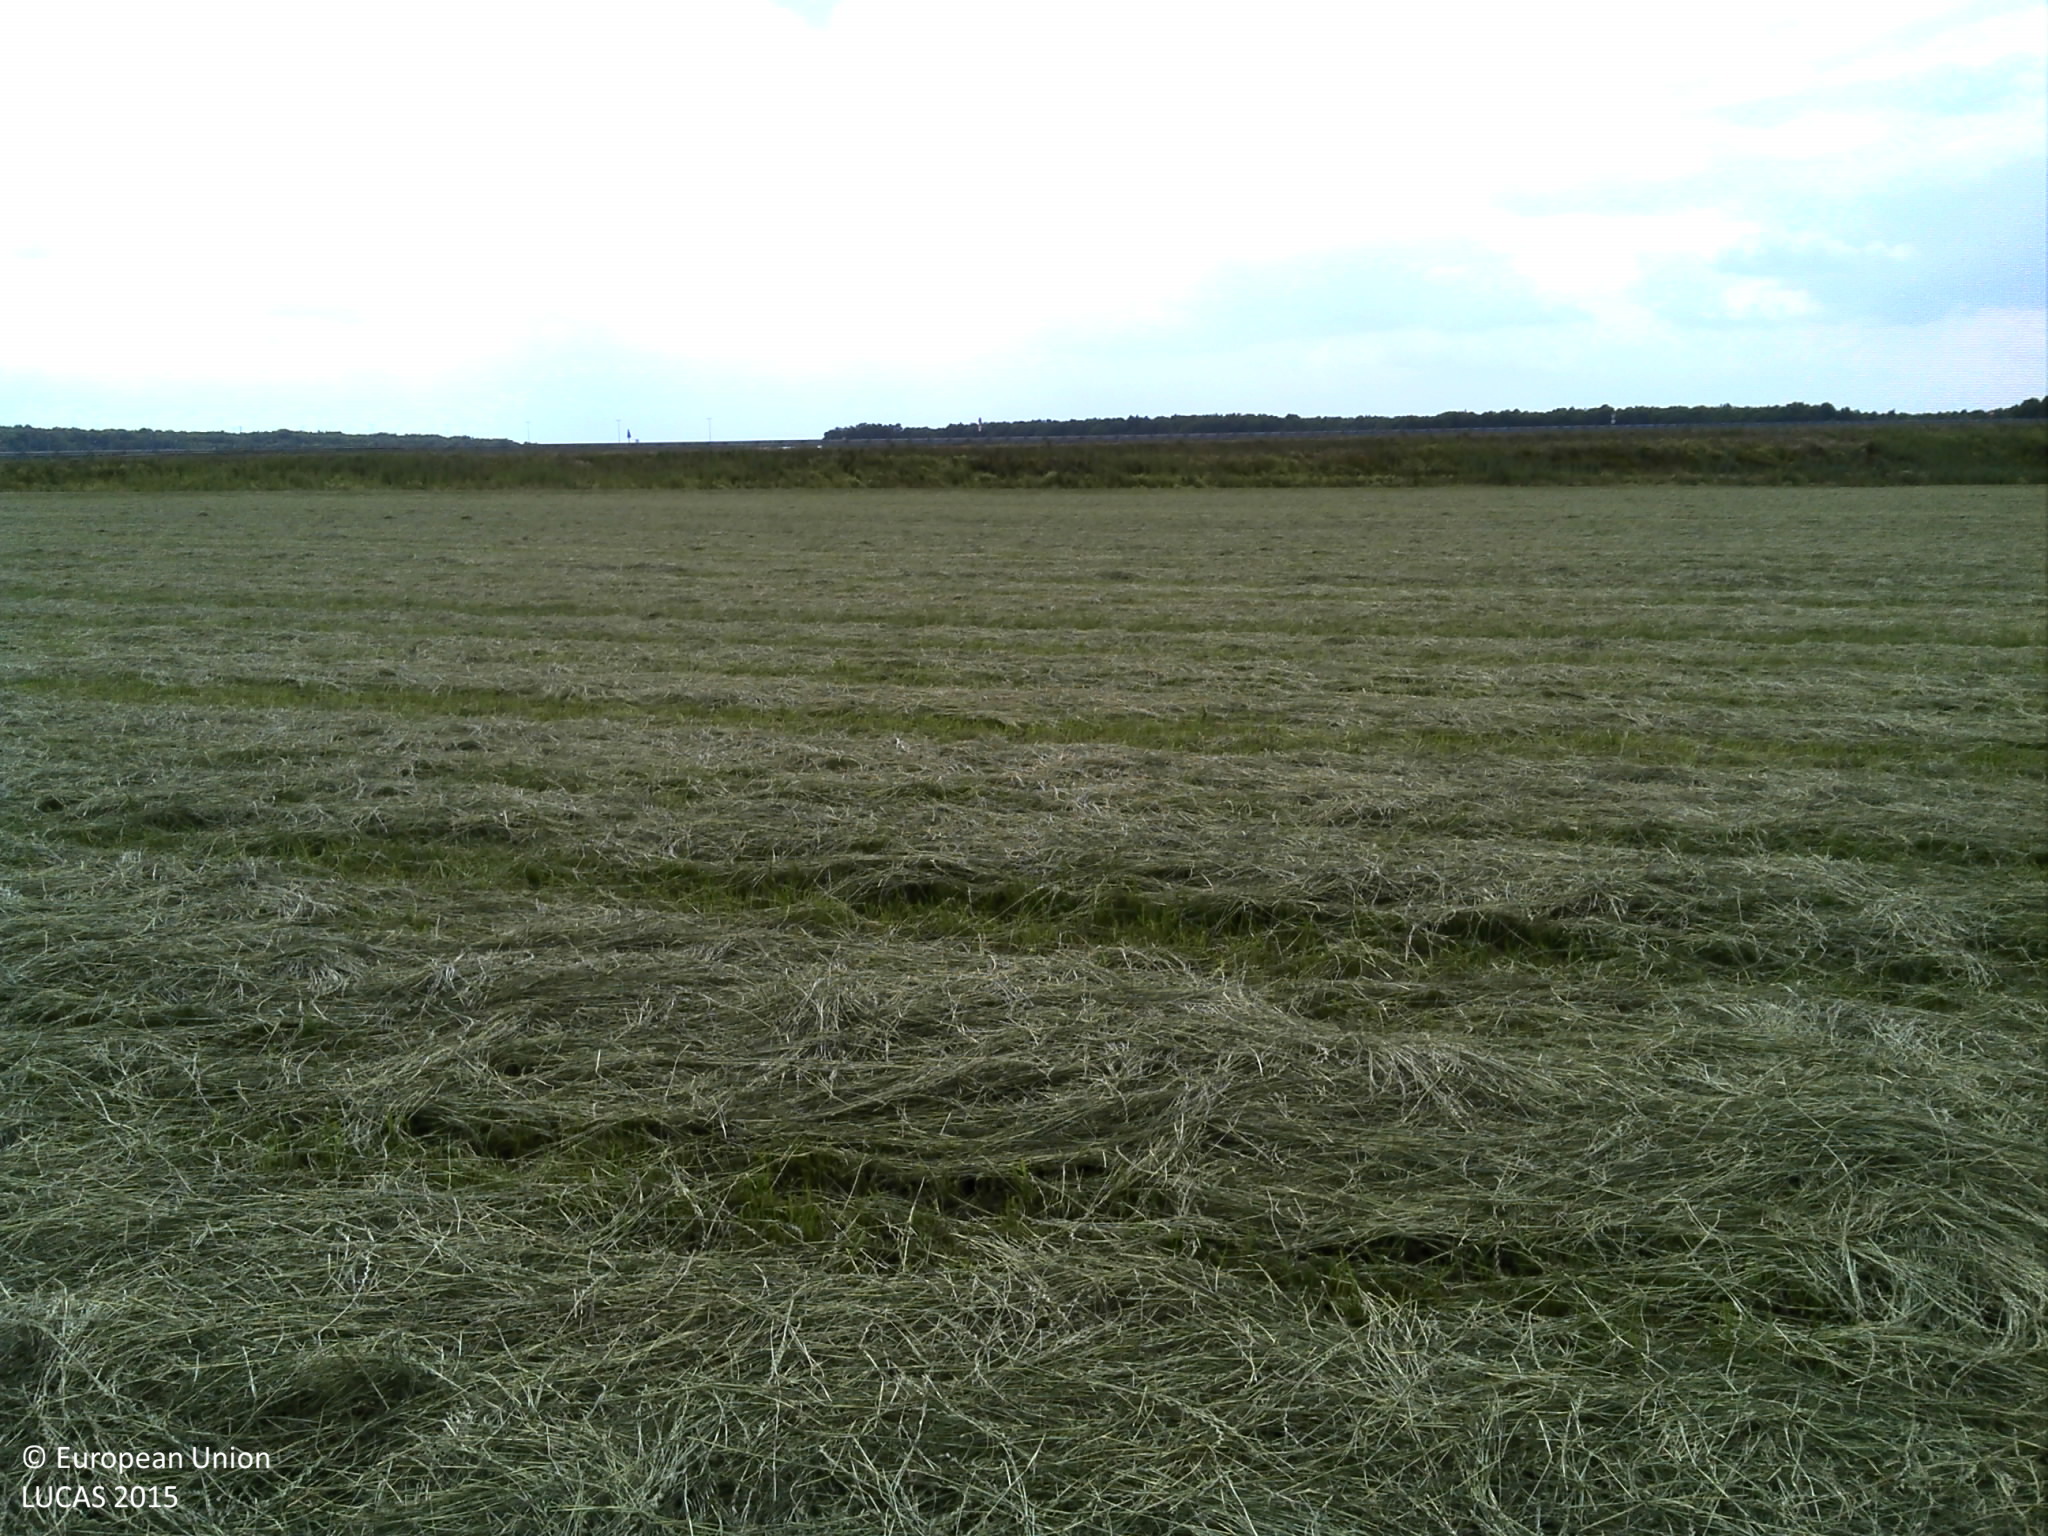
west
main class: Grassland
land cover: Grassland without tree/shrub cover
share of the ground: > 75 %
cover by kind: herbaceous plants 100 %
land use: Agriculture (excluding fallow land and kitchen gardens)
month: June
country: HR
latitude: 45.4027
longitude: 18.4247
